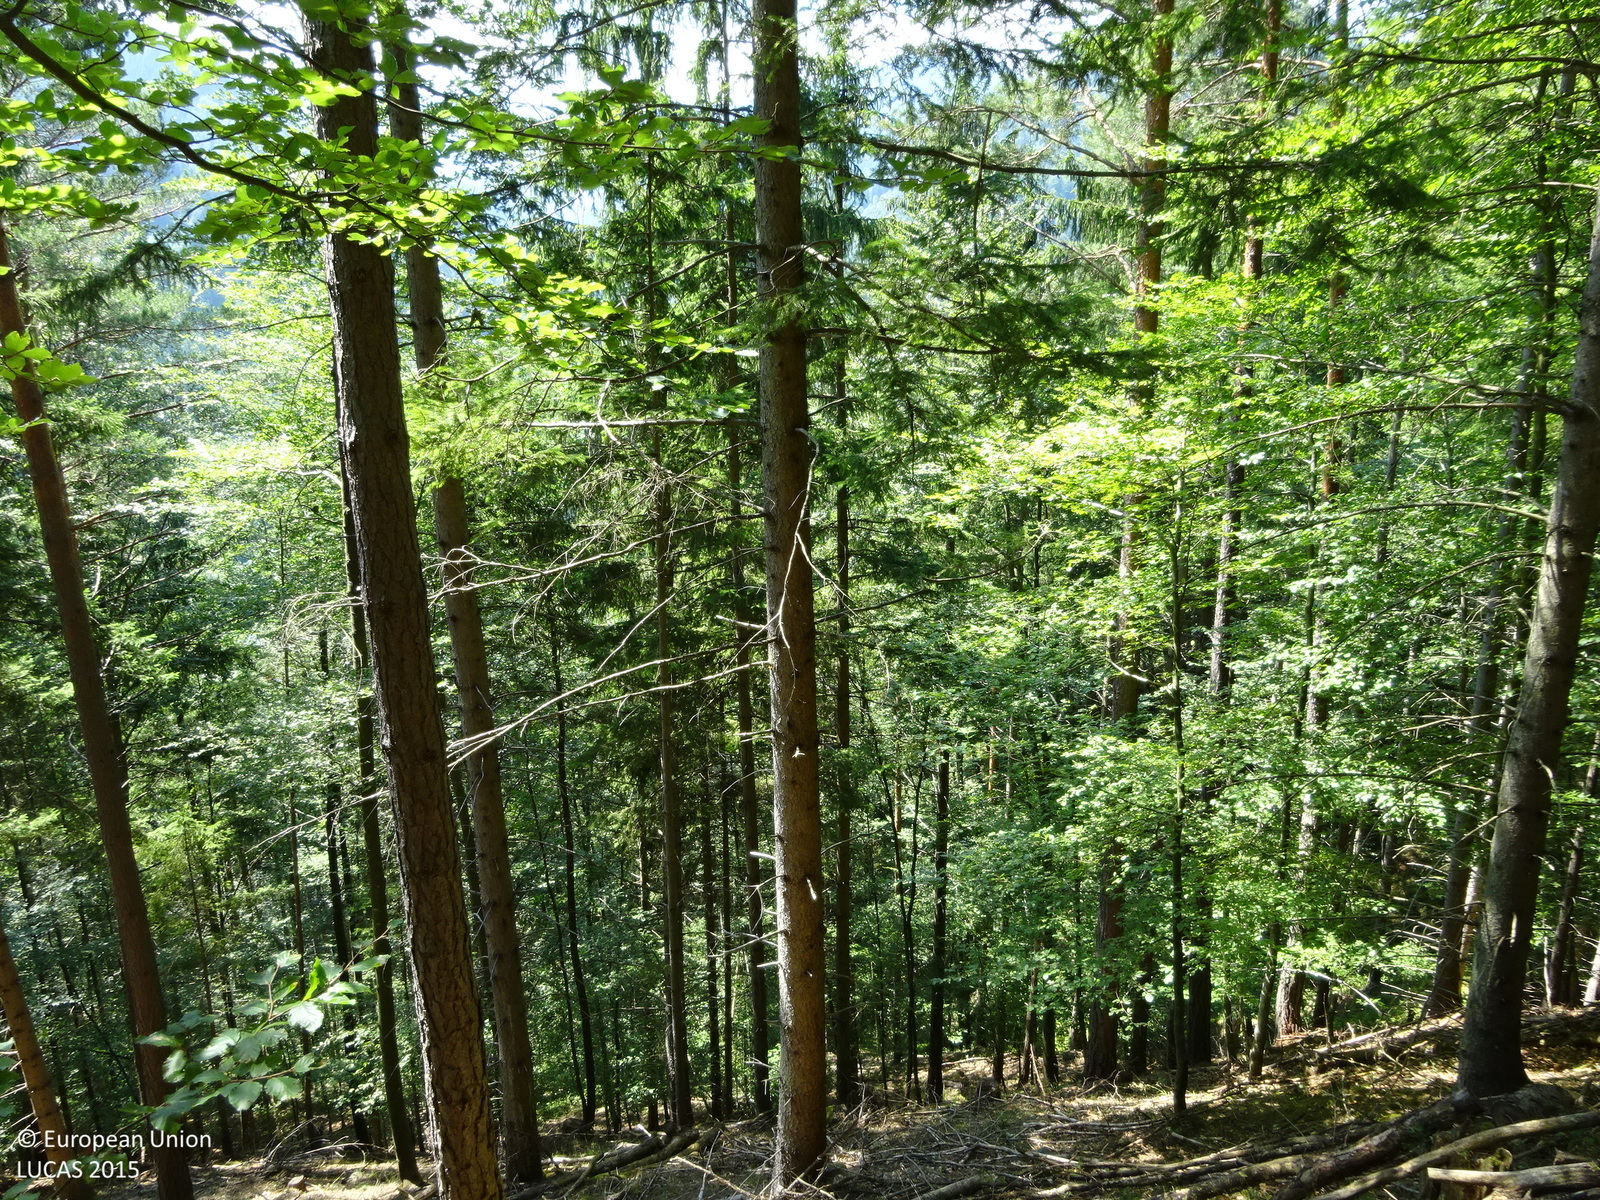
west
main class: Woodland
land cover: Pine dominated mixed woodland
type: hemiboreal forest and nemoral coniferous forest and mixed broadleaved-coniferous forest
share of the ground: > 75 %
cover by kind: coniferous forest trees 45 %, broadleaved forest trees 45 %, lichens and mosses 5 %, unconsolidated bare surface 5 %
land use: Forestry
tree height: > 5 m
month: July
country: AT
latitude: 47.2857
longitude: 15.2754
